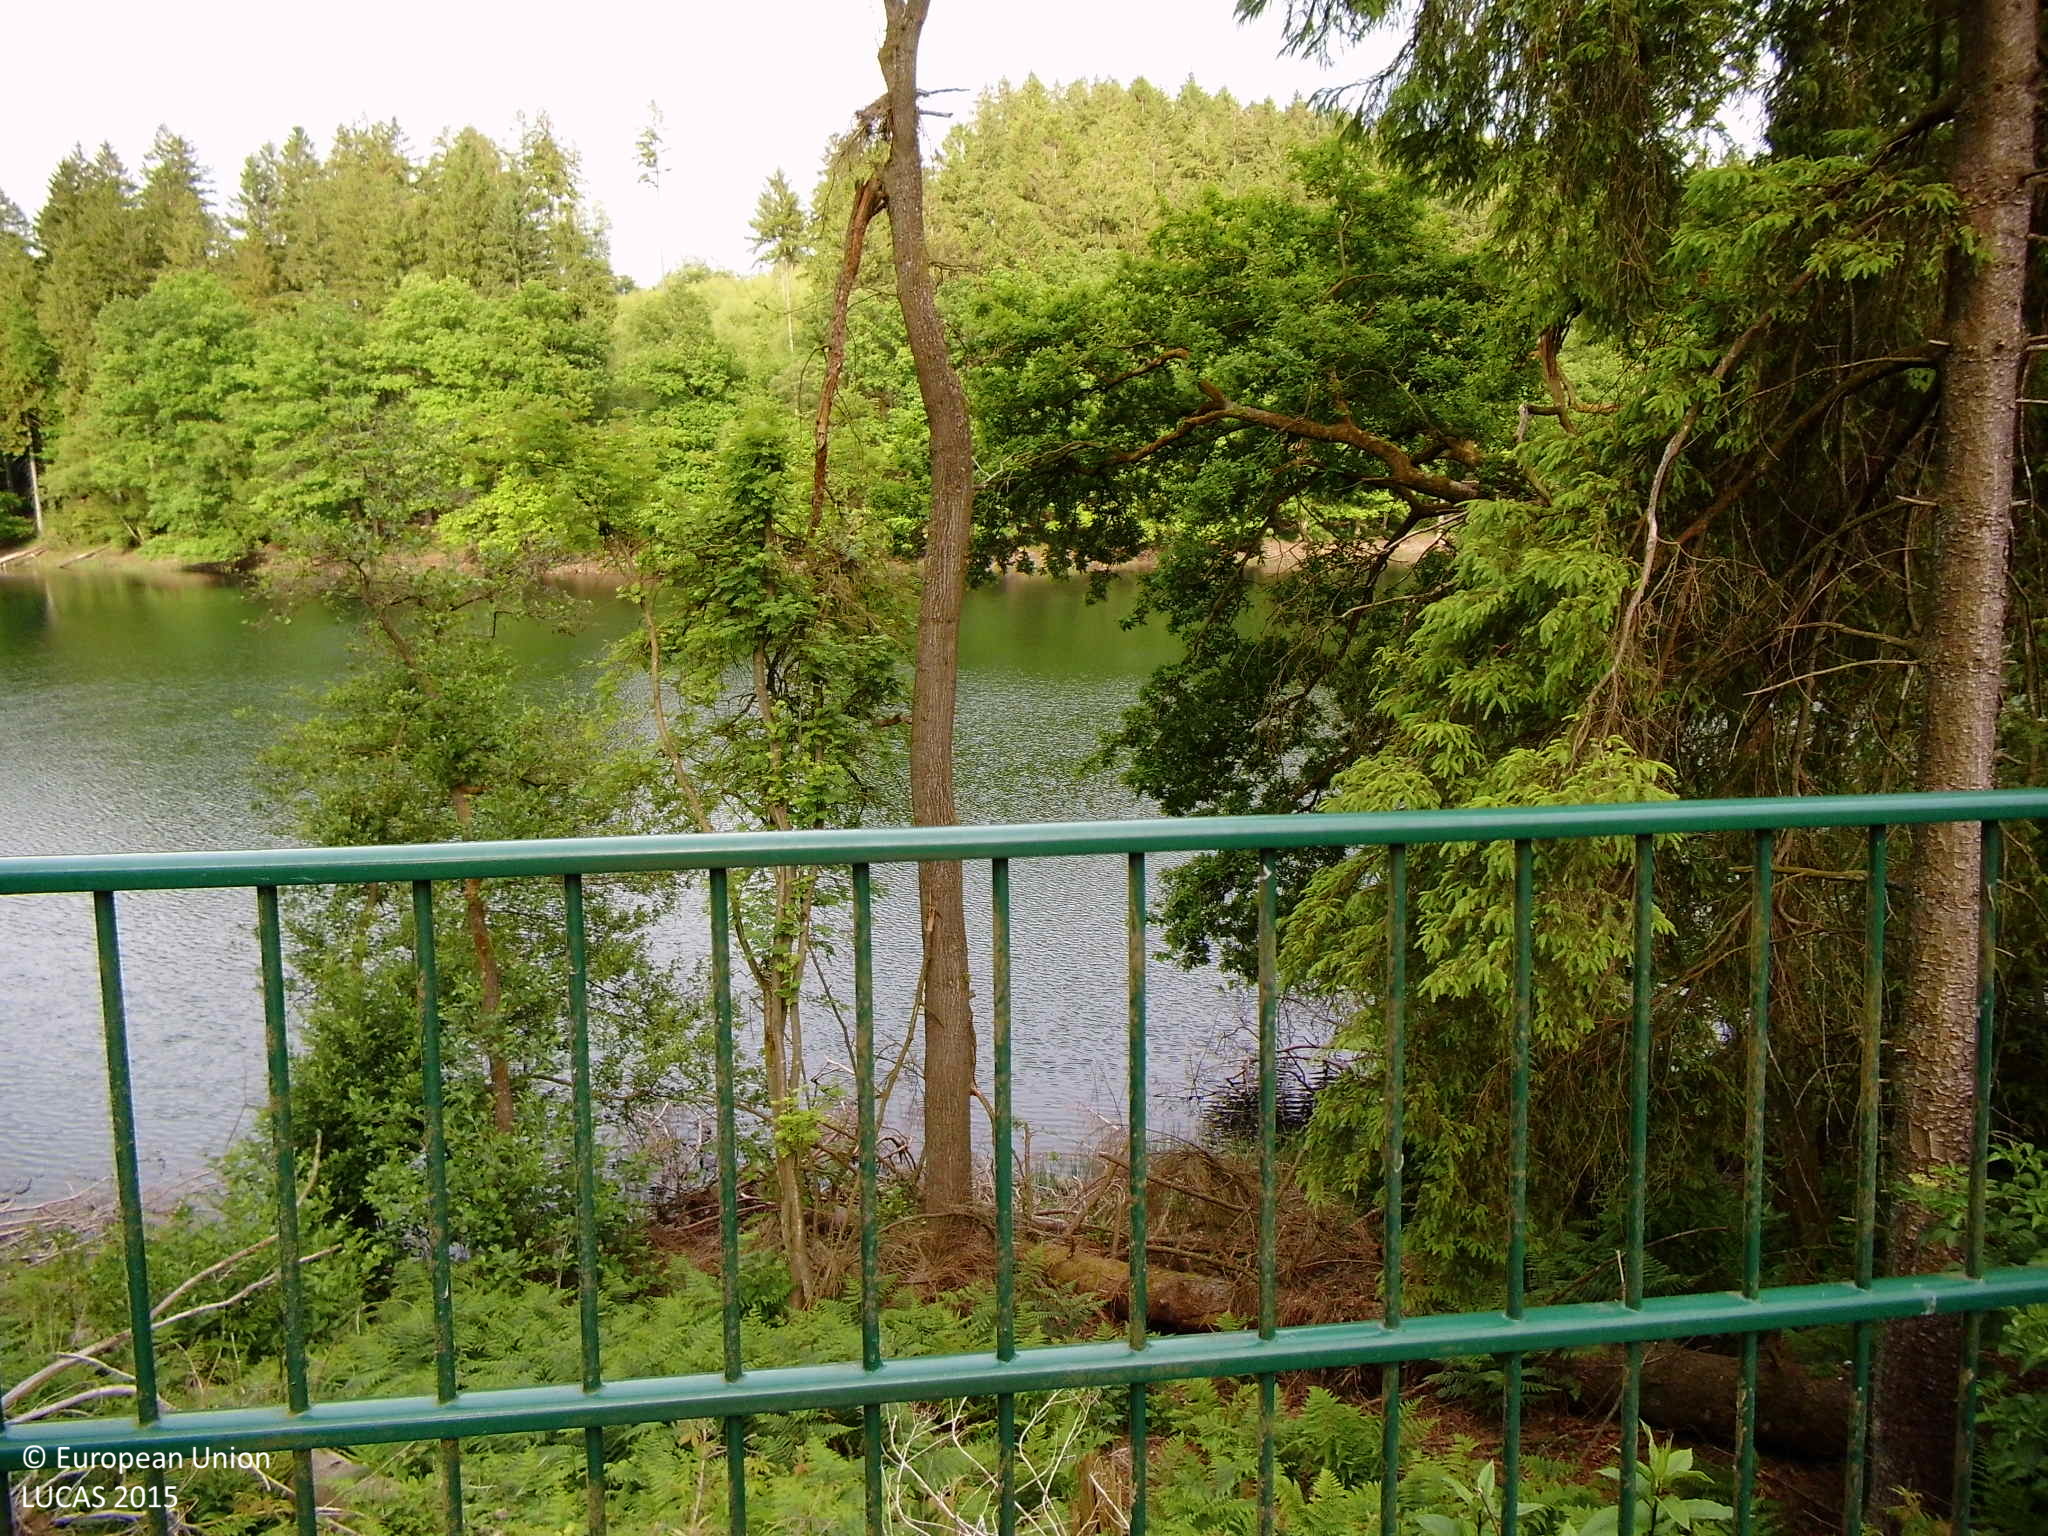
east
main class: Woodland
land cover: Spruce dominated mixed woodland
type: hemiboreal forest and nemoral coniferous forest and mixed broadleaved-coniferous forest
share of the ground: > 75 %
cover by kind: coniferous forest trees 40 %, broadleaved forest trees 35 %, herbaceous plants 10 %, unconsolidated bare surface 10 %, shrubs 5 %
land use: Forestry
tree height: > 5 m
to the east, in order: Spruce dominated mixed woodland; Tracks; Spruce dominated mixed woodland; Inland fresh water bodies
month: June
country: DE
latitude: 51.2341
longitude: 7.4079
